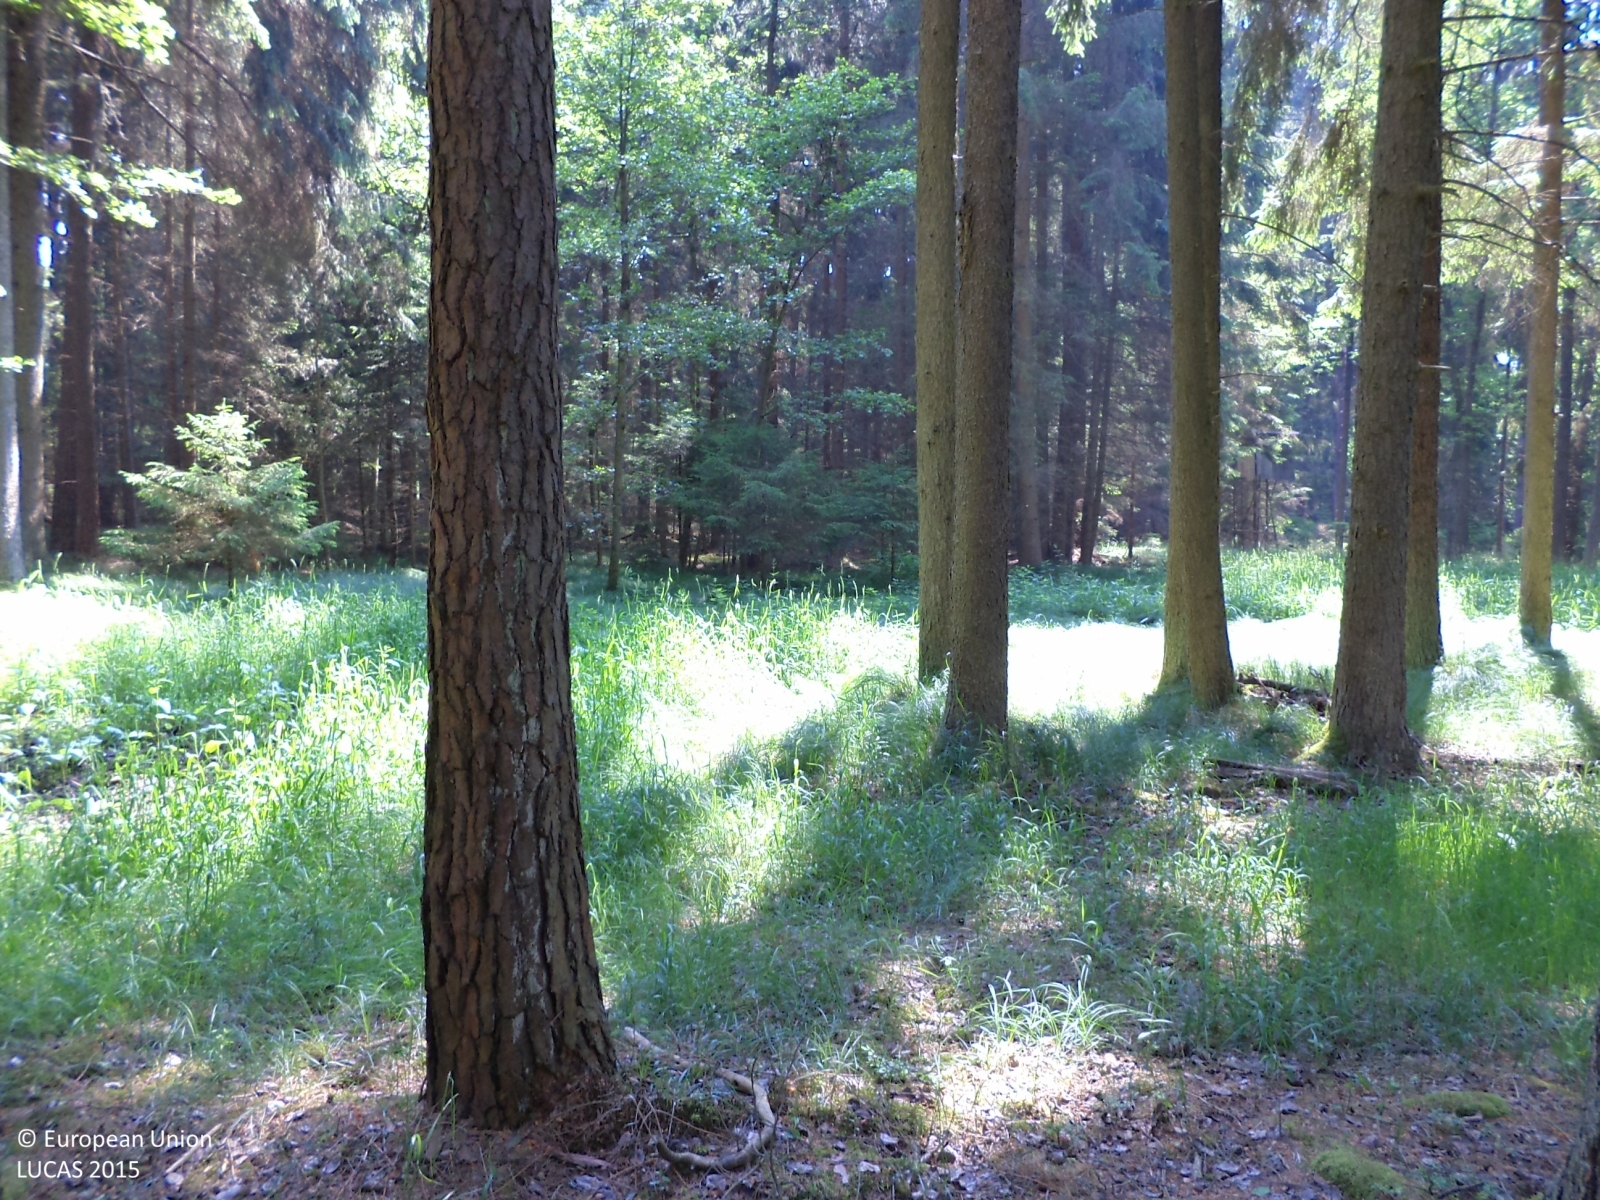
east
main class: Woodland
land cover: Spruce dominated coniferous woodland
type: hemiboreal forest and nemoral coniferous forest and mixed broadleaved-coniferous forest
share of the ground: > 75 %
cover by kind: coniferous forest trees 80 %, herbaceous plants 20 %
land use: Forestry
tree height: > 5 m
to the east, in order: Spruce dominated coniferous woodland; Rivers and streams; Spruce dominated coniferous woodland; Spruce dominated mixed woodland; Ditches and canals; Grass margins
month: June
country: CZ
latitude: 49.3421
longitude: 14.4194
